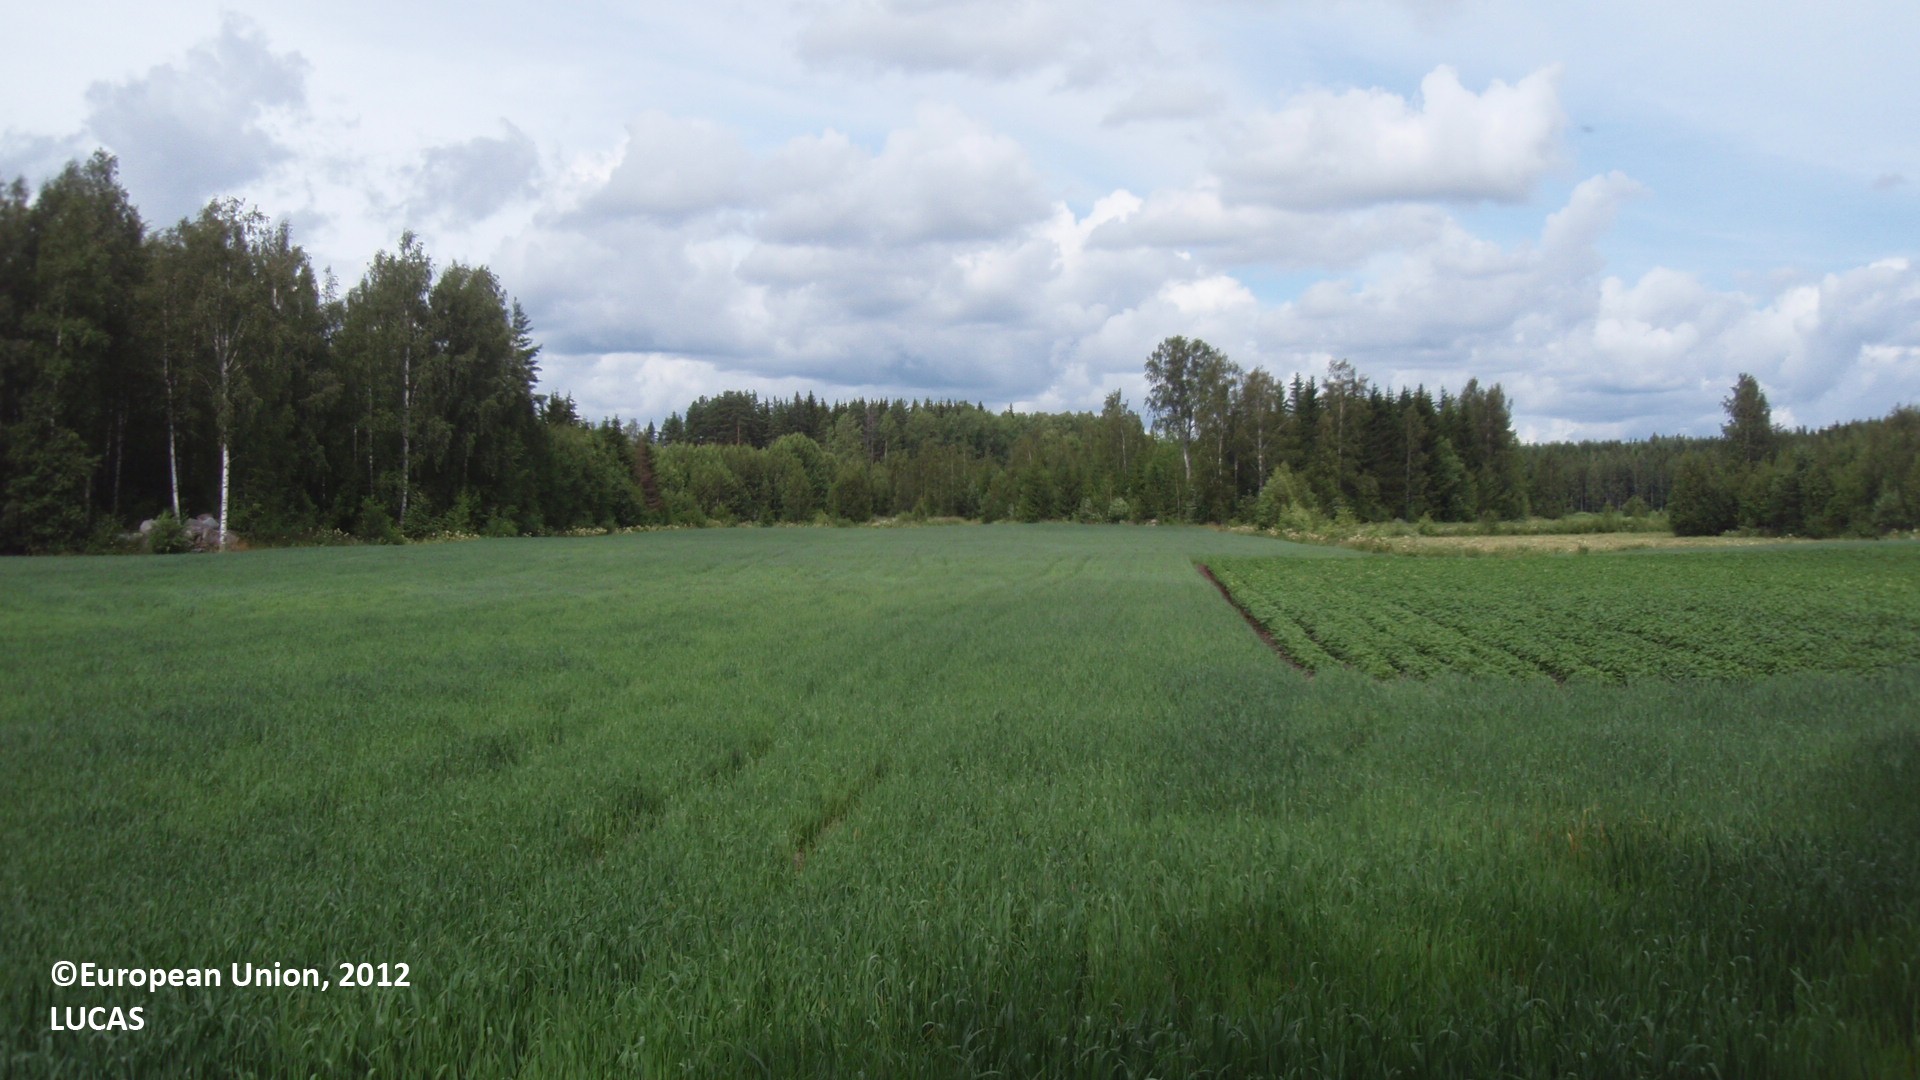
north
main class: Cropland
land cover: Oats
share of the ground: > 75 %
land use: Agriculture (excluding fallow land and kitchen gardens)
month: July
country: FI
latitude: 61.3169
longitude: 28.6537
